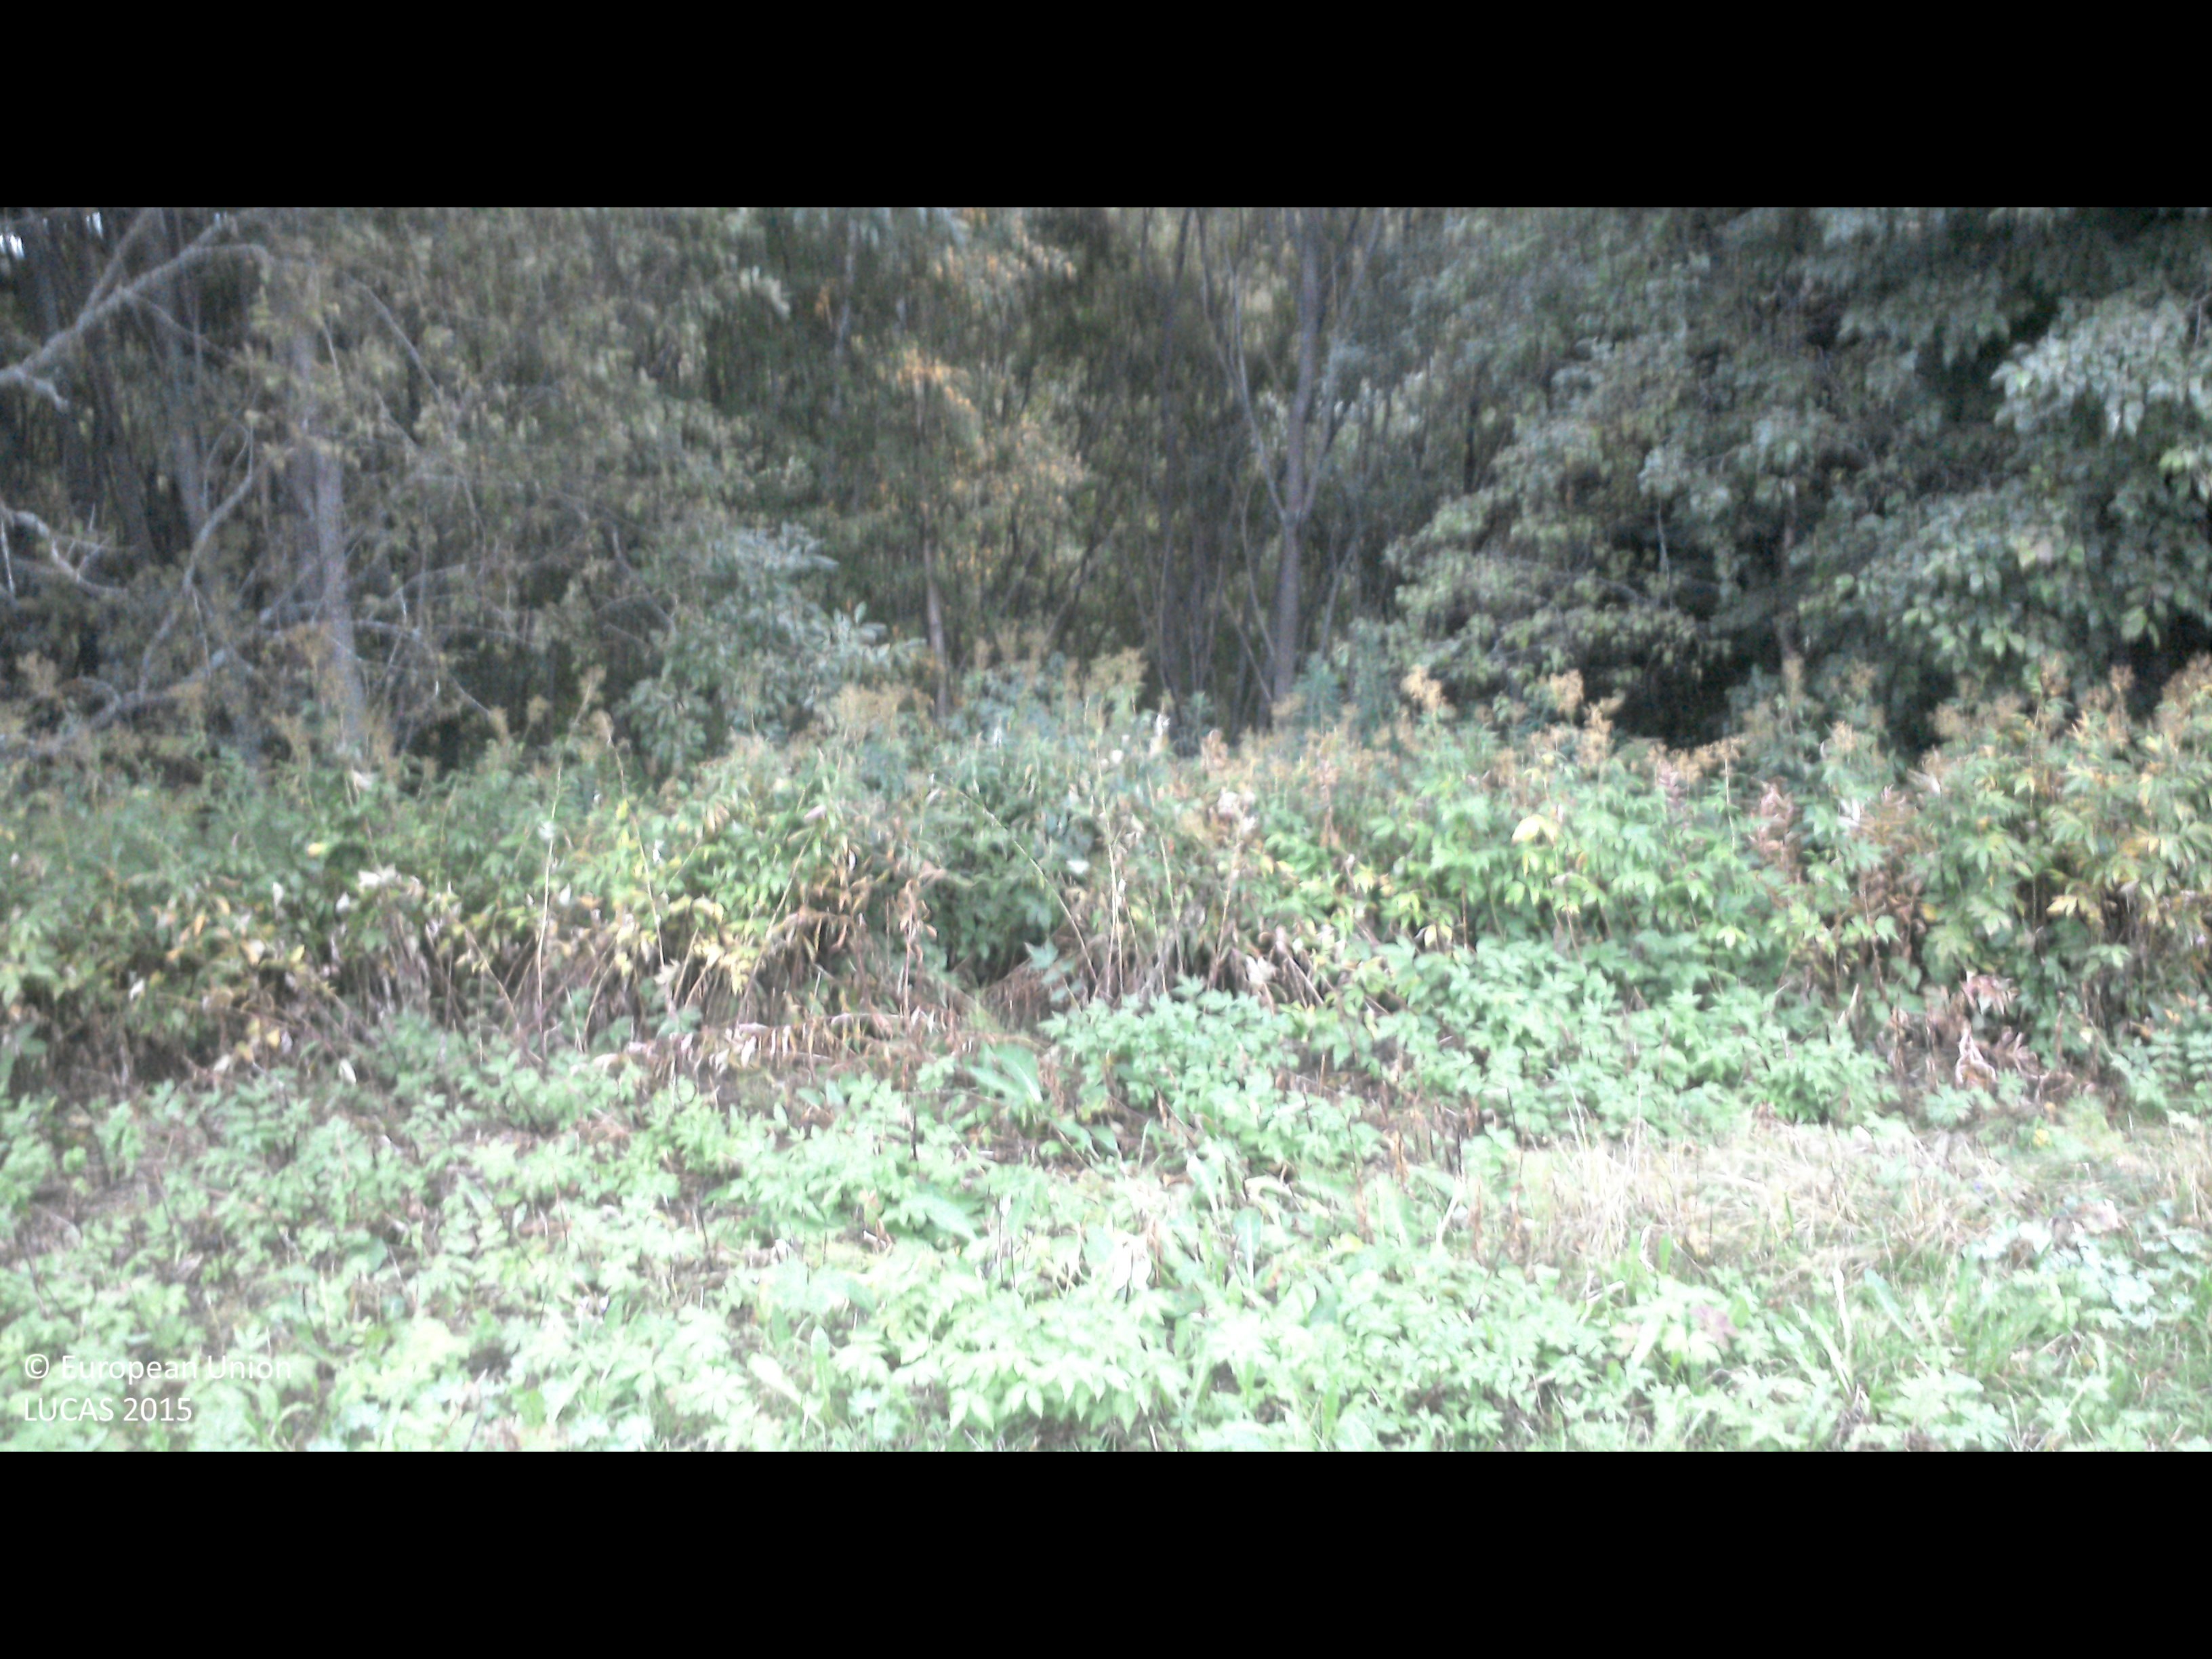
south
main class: Grassland
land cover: Grassland without tree/shrub cover
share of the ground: > 75 %
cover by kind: herbaceous plants 100 %
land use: Agriculture (excluding fallow land and kitchen gardens)
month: September
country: SE
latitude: 63.8574
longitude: 20.0905
